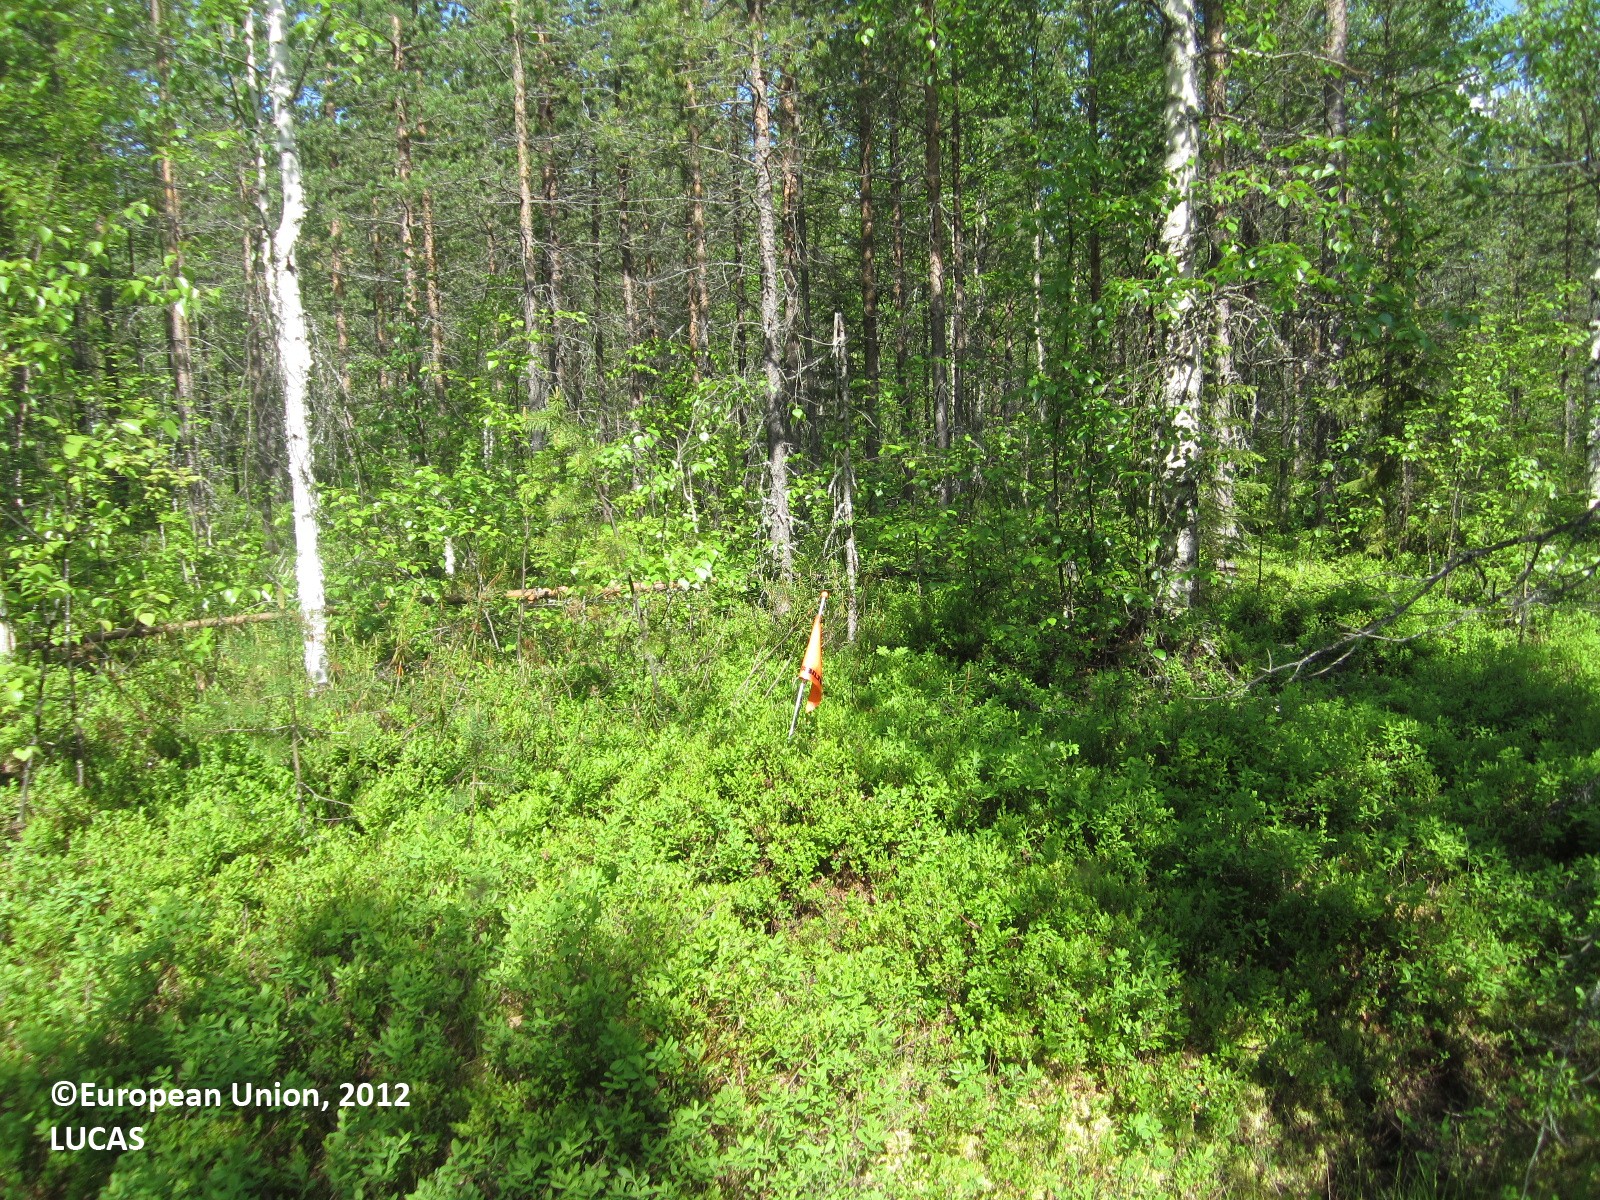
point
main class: Woodland
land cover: Pine dominated mixed woodland
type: boreal forest
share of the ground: 50 - 75 %
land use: Forestry
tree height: > 5 m
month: June
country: FI
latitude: 64.7977
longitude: 28.8975
